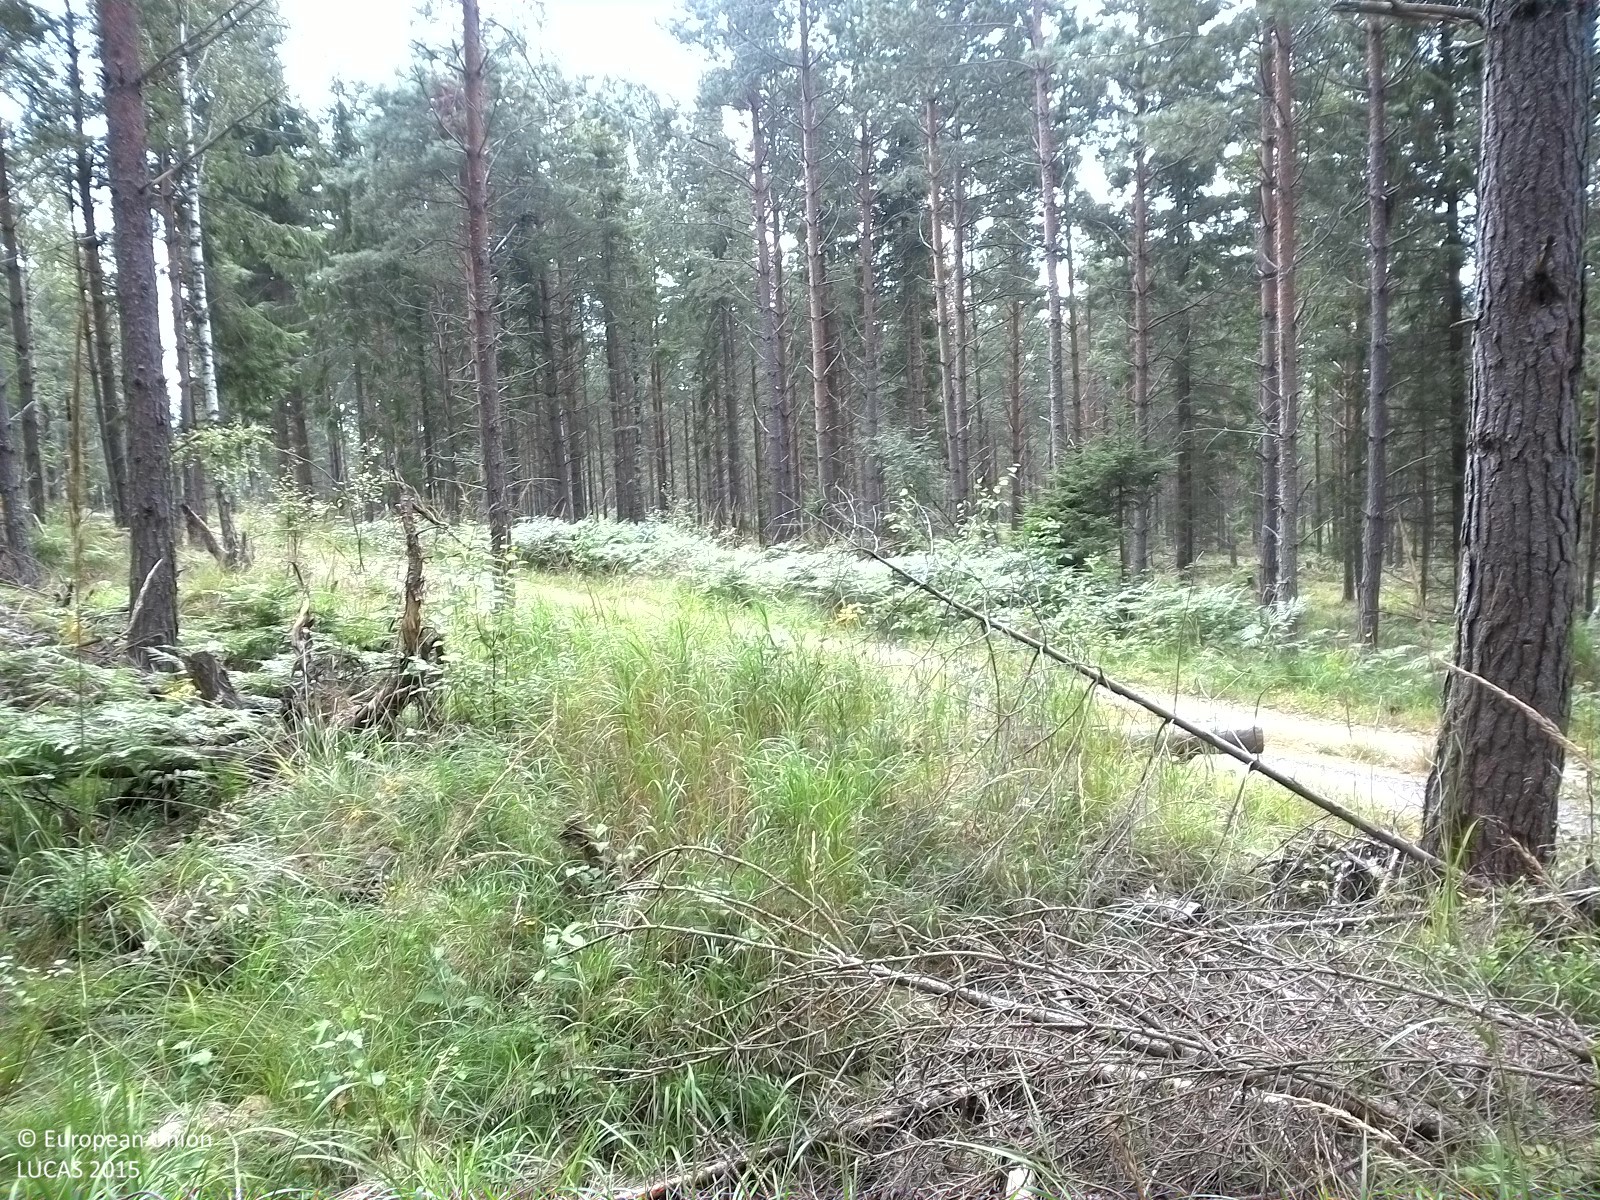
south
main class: Woodland
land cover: Pine dominated mixed woodland
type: boreal forest
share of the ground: 25 - 50 %
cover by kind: herbaceous plants 65 %, coniferous forest trees 20 %, broadleaved forest trees 10 %, lichens and mosses 5 %
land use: Forestry
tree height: > 5 m
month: August
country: SE
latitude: 59.0218
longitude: 15.1656
